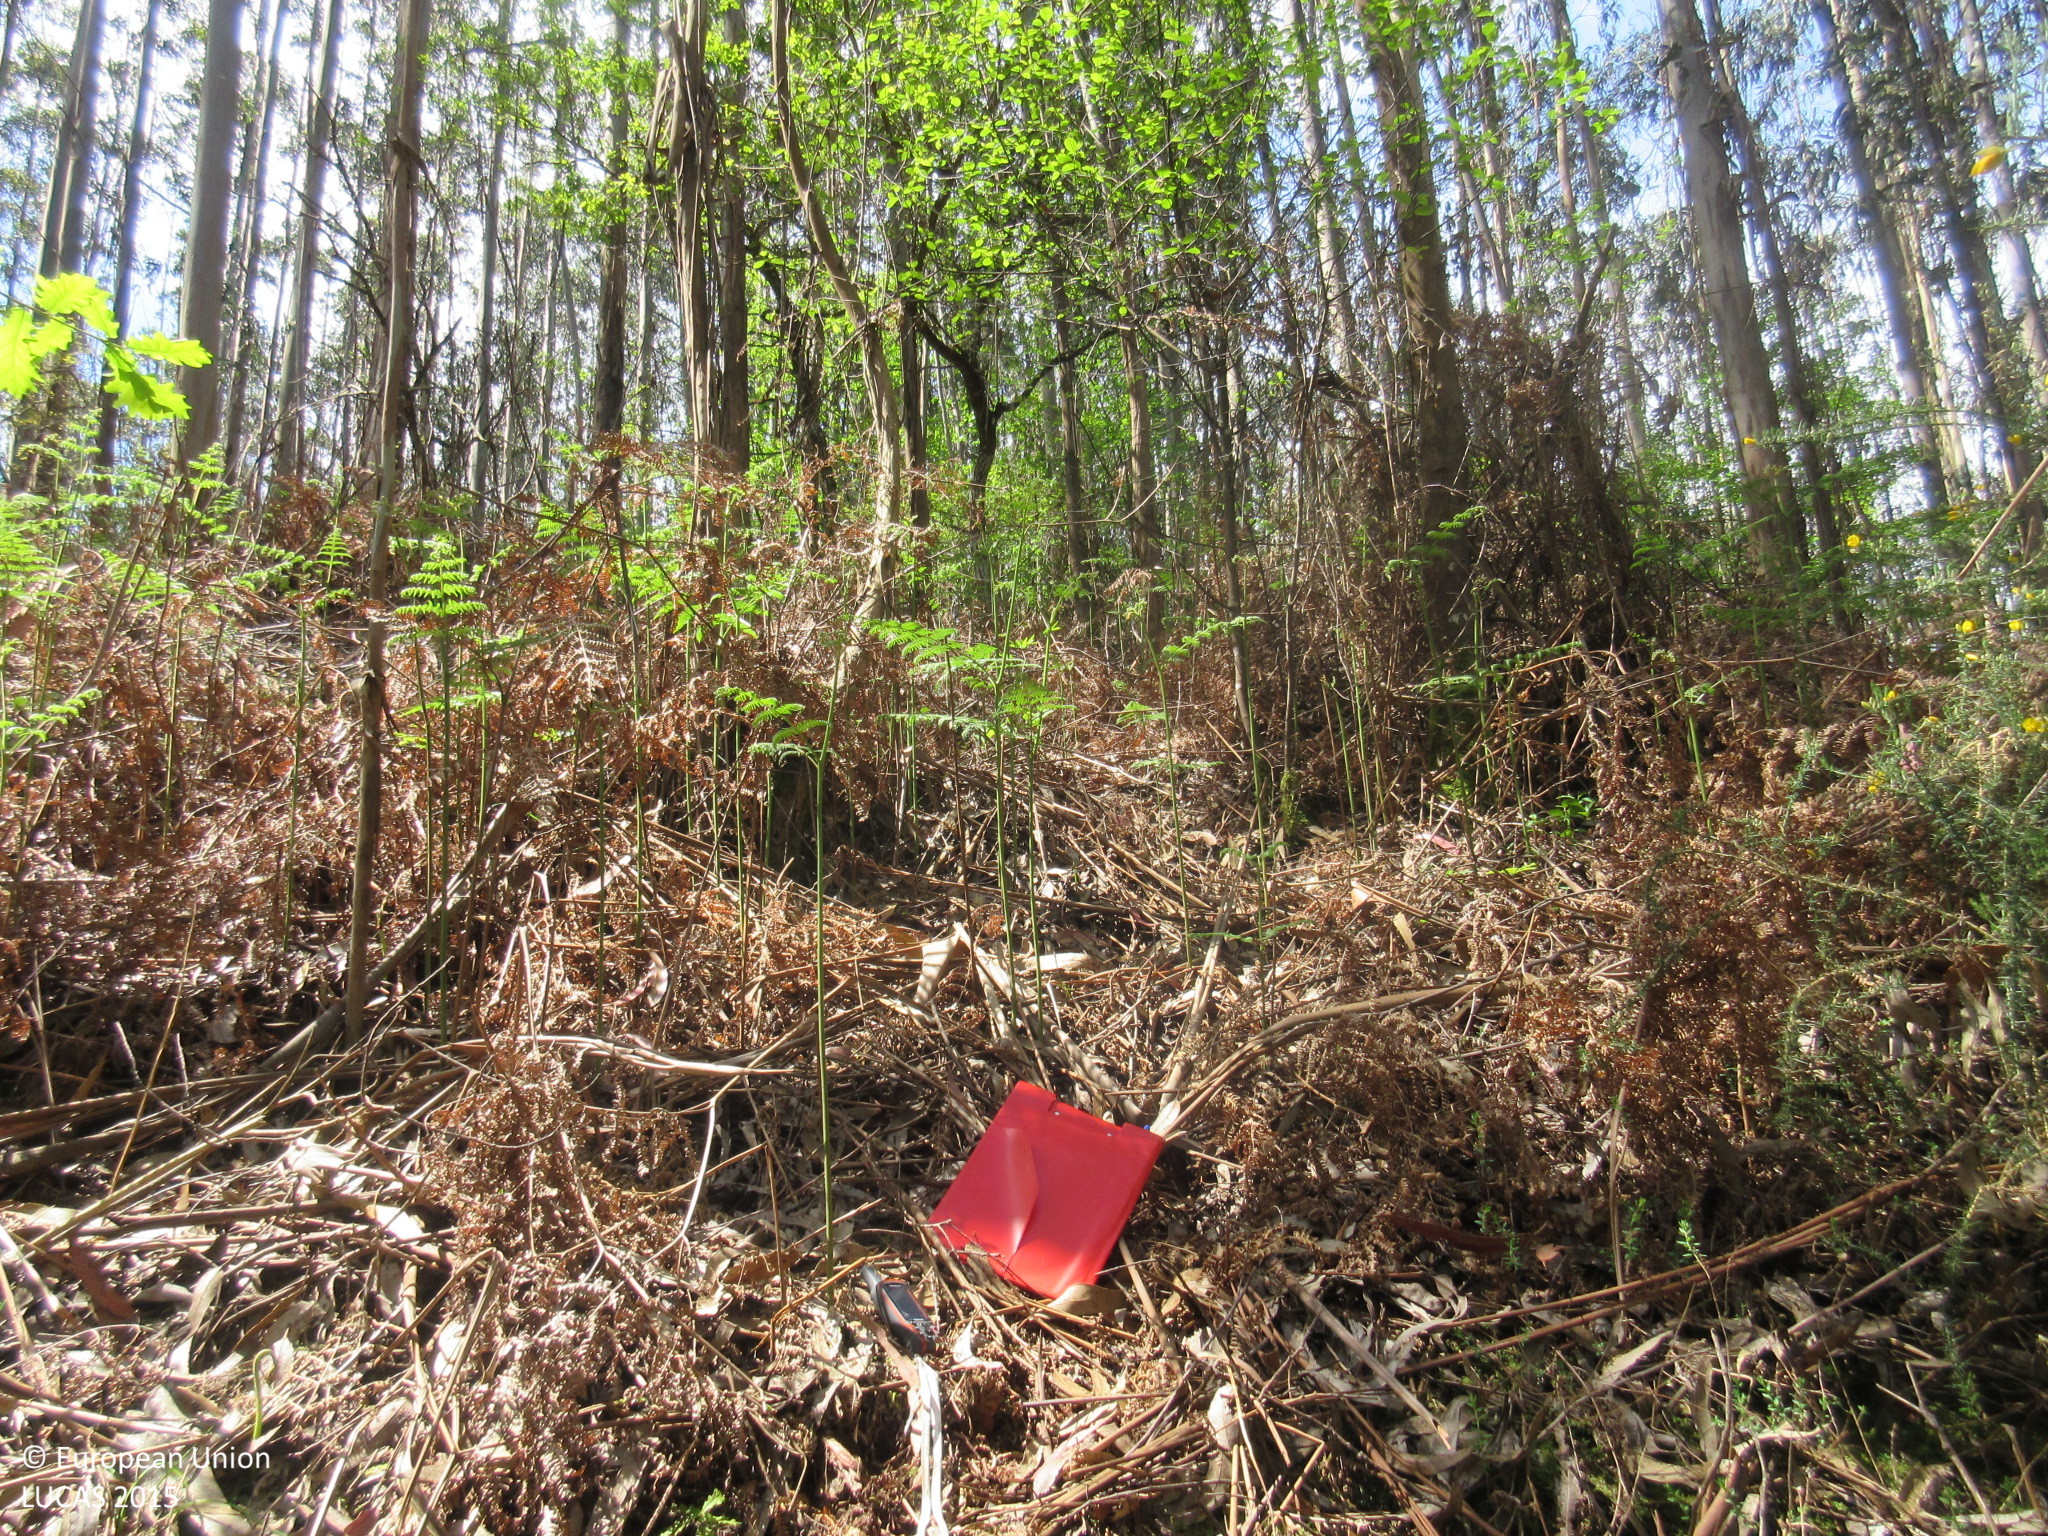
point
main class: Woodland
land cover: Broadleaved woodland
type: exotic forest
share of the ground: > 75 %
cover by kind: broadleaved forest trees 95 %, shrubs 5 %
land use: Forestry
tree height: > 5 m
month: April
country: ES
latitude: 43.5109
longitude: -7.0785
